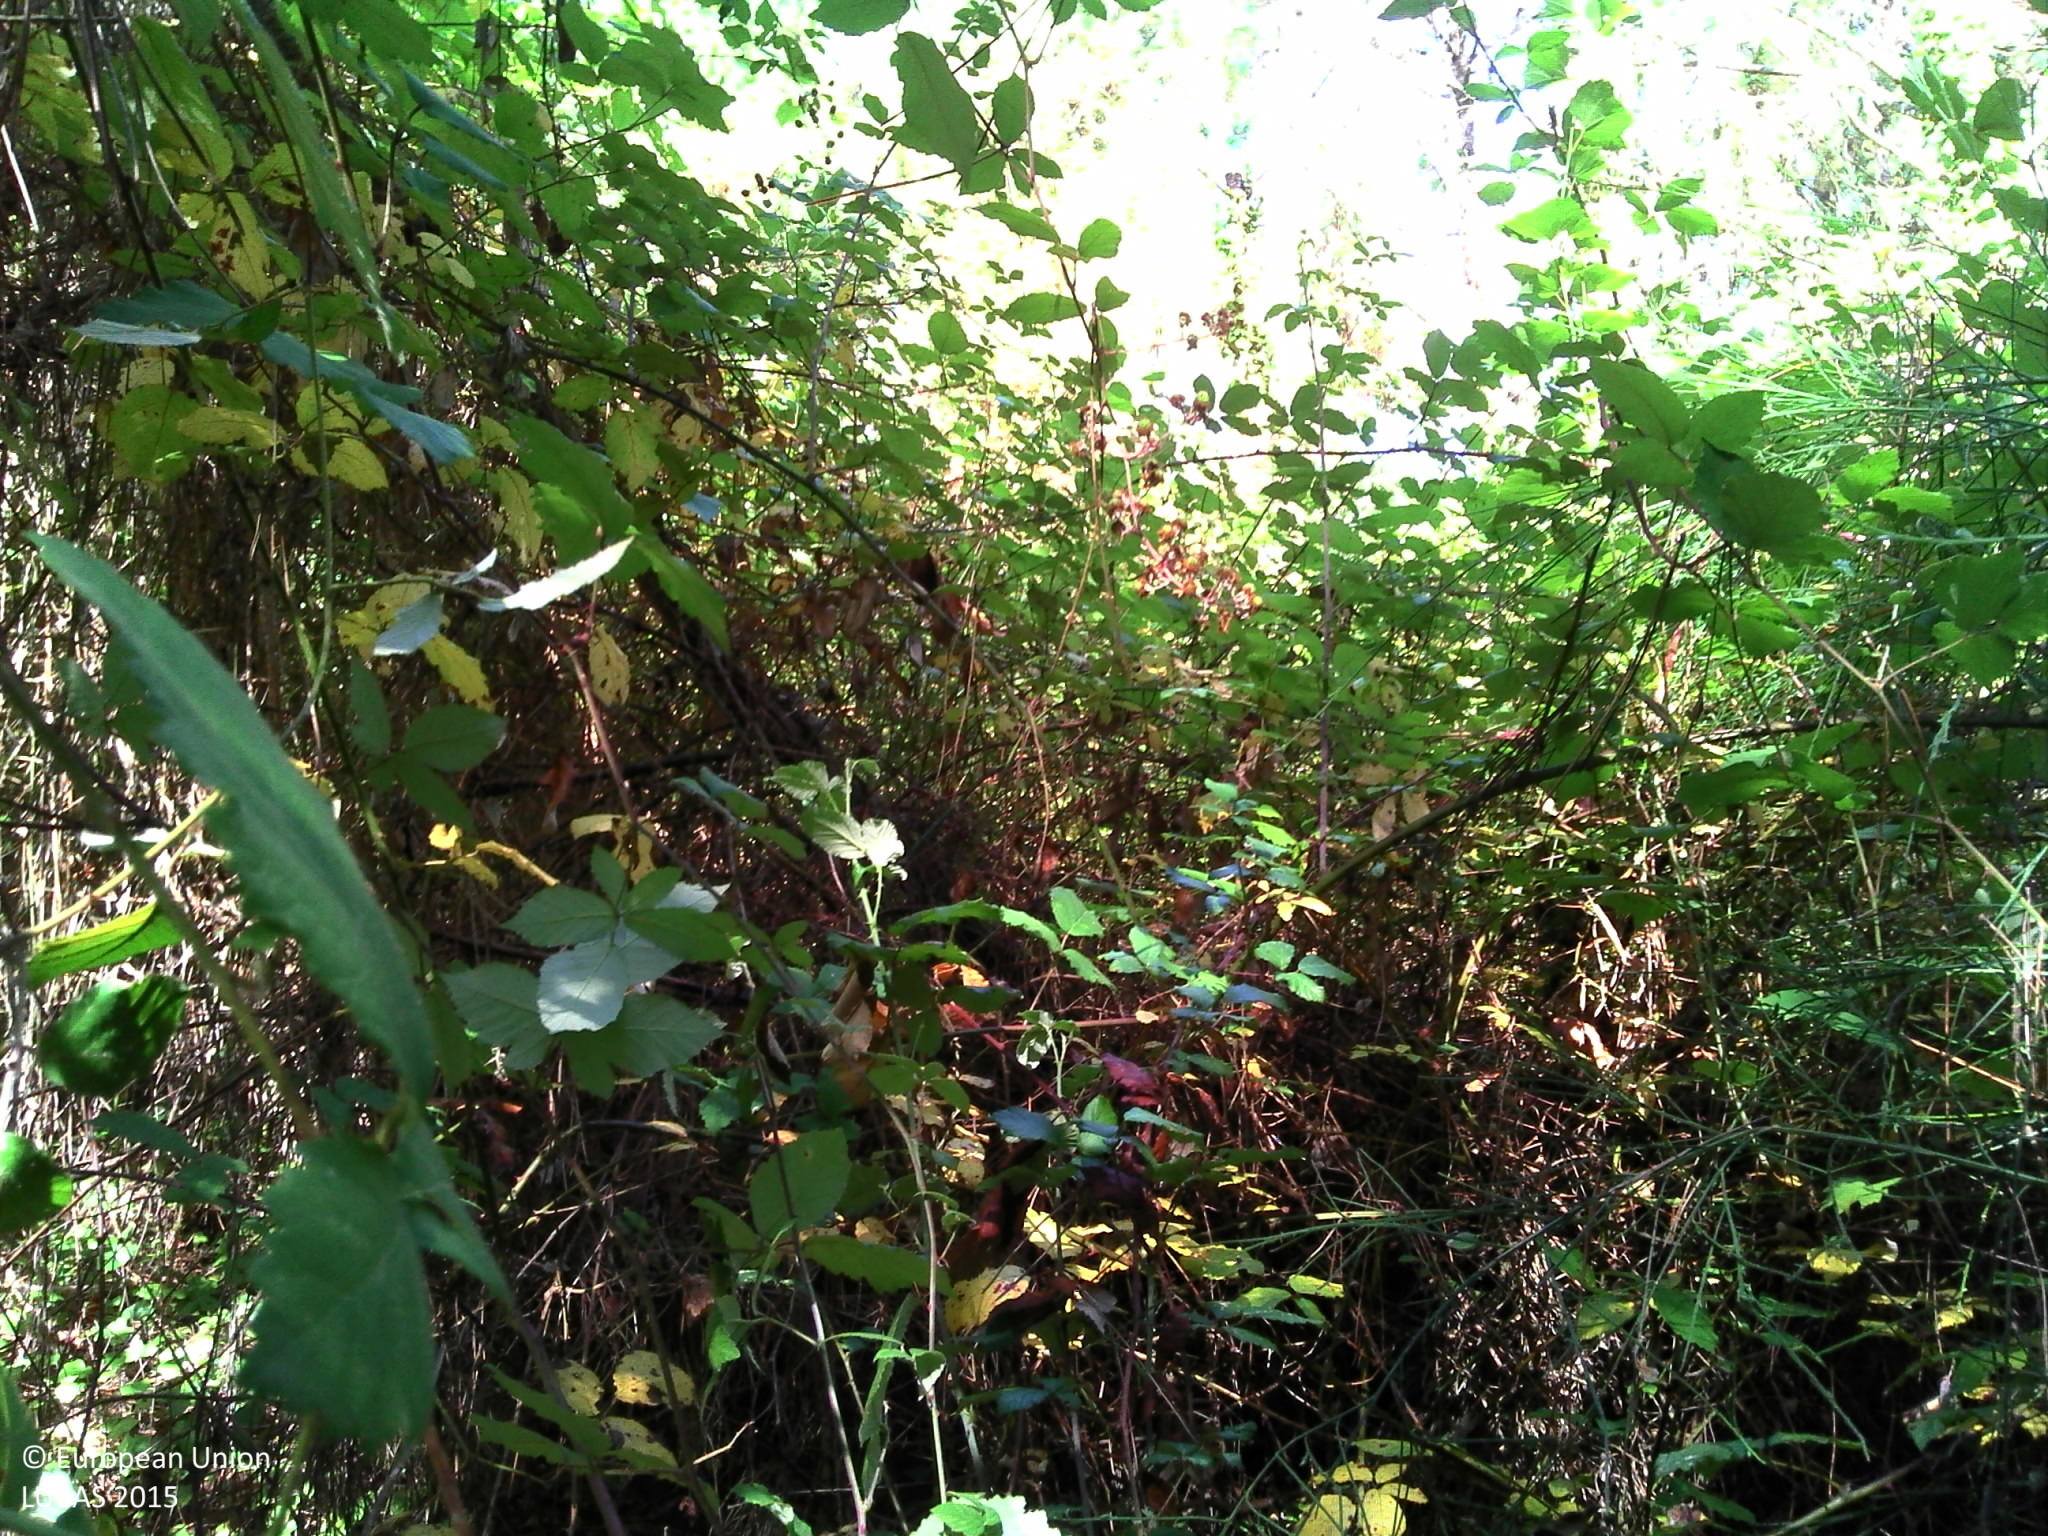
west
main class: Woodland
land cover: Pine dominated mixed woodland
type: thermophilous deciduous forest
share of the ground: > 75 %
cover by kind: coniferous forest trees 50 %, broadleaved forest trees 20 %, shrubs 20 %, herbaceous plants 5 %, lichens and mosses 5 %
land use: Forestry
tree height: > 5 m
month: July
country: FR
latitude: 45.0527
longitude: 0.4531
